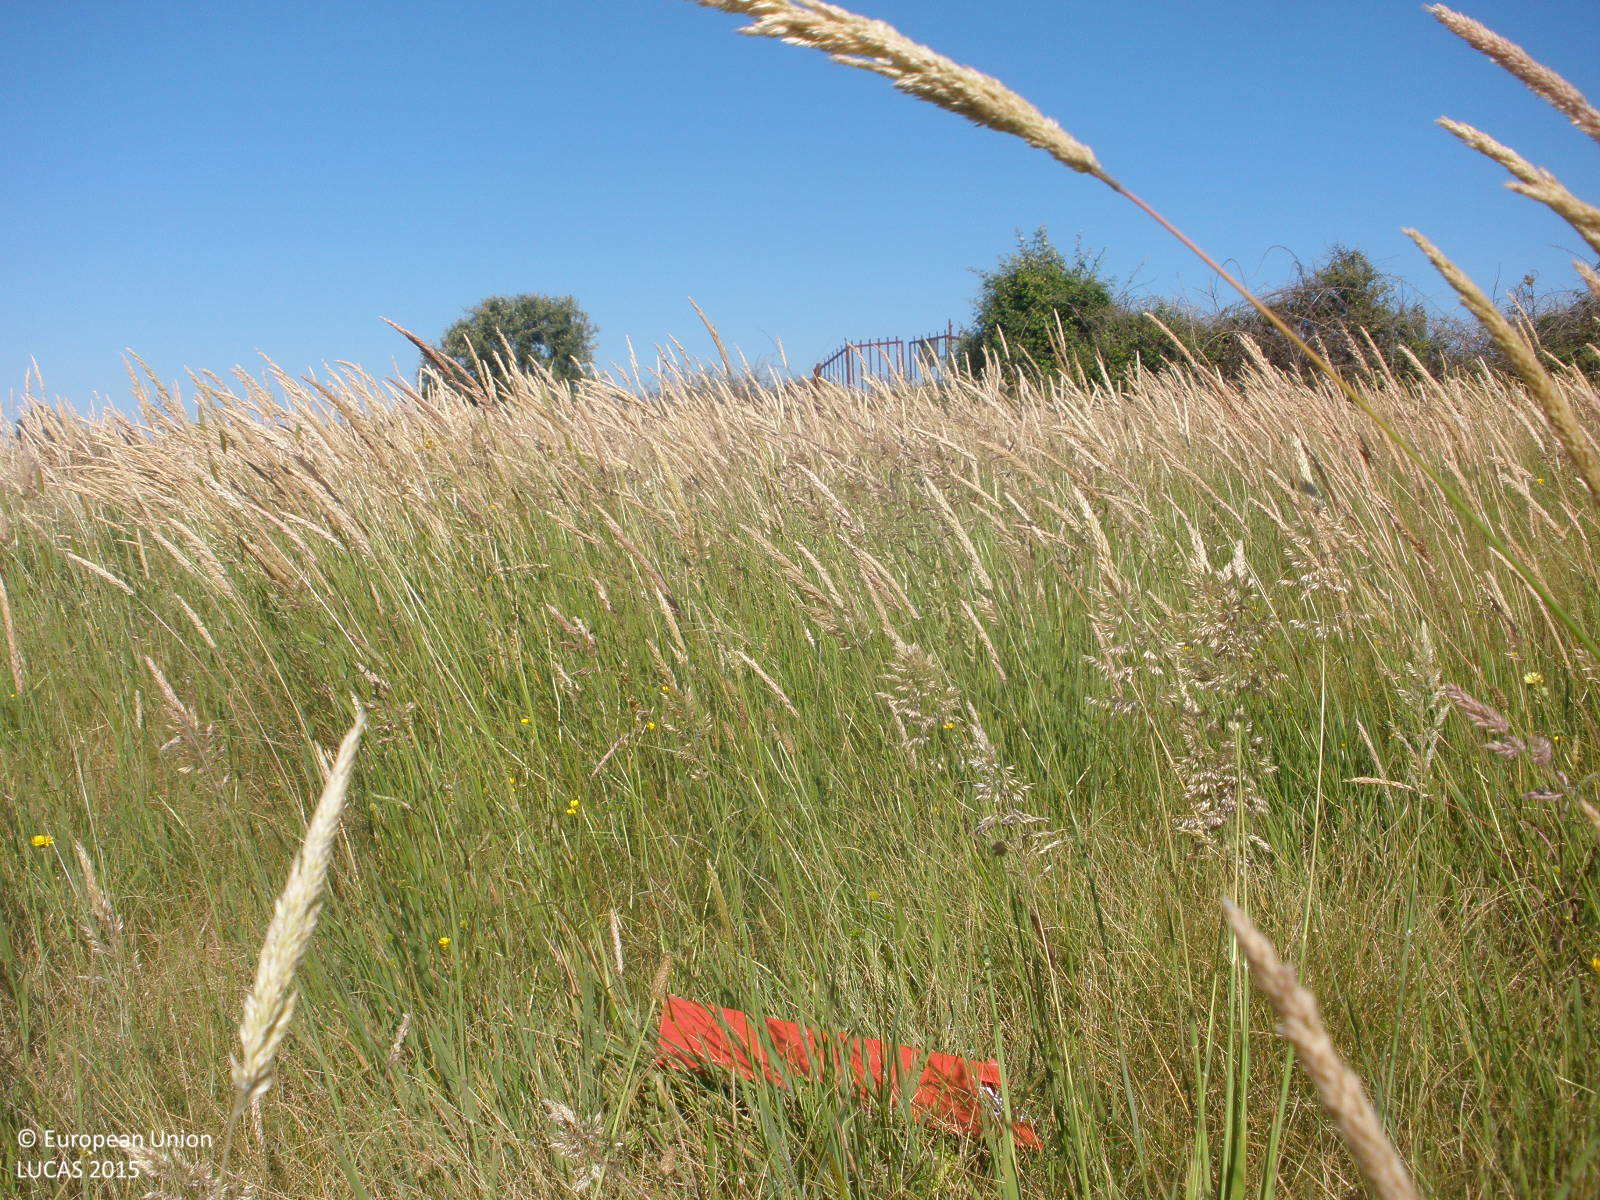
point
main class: Grassland
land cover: Grassland without tree/shrub cover
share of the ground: > 75 %
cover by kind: herbaceous plants 100 %
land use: Agriculture (excluding fallow land and kitchen gardens)
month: May
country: ES
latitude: 40.2398
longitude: -6.2883
